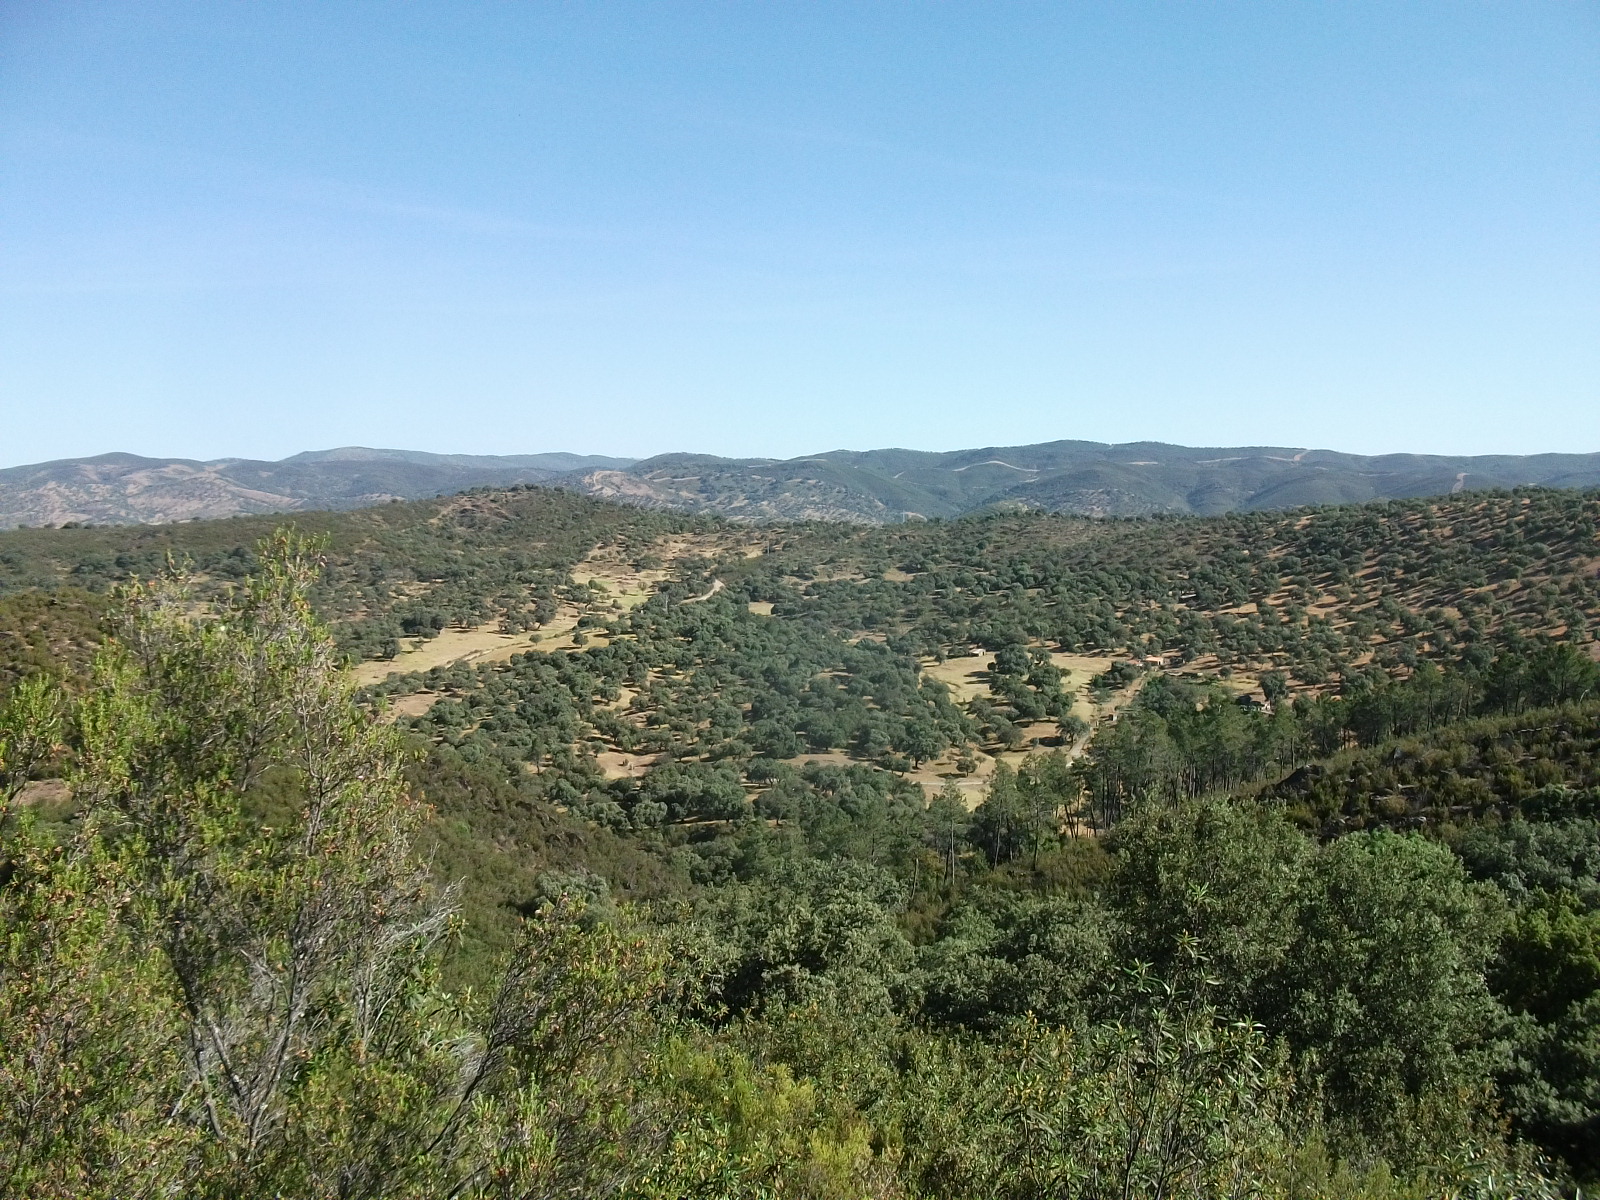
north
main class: Shrubland
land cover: Shrubland without tree cover
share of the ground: > 75 %
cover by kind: shrubs 100 %
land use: Agriculture (excluding fallow land and kitchen gardens)
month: May
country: ES
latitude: 37.9424
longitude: -6.5783
